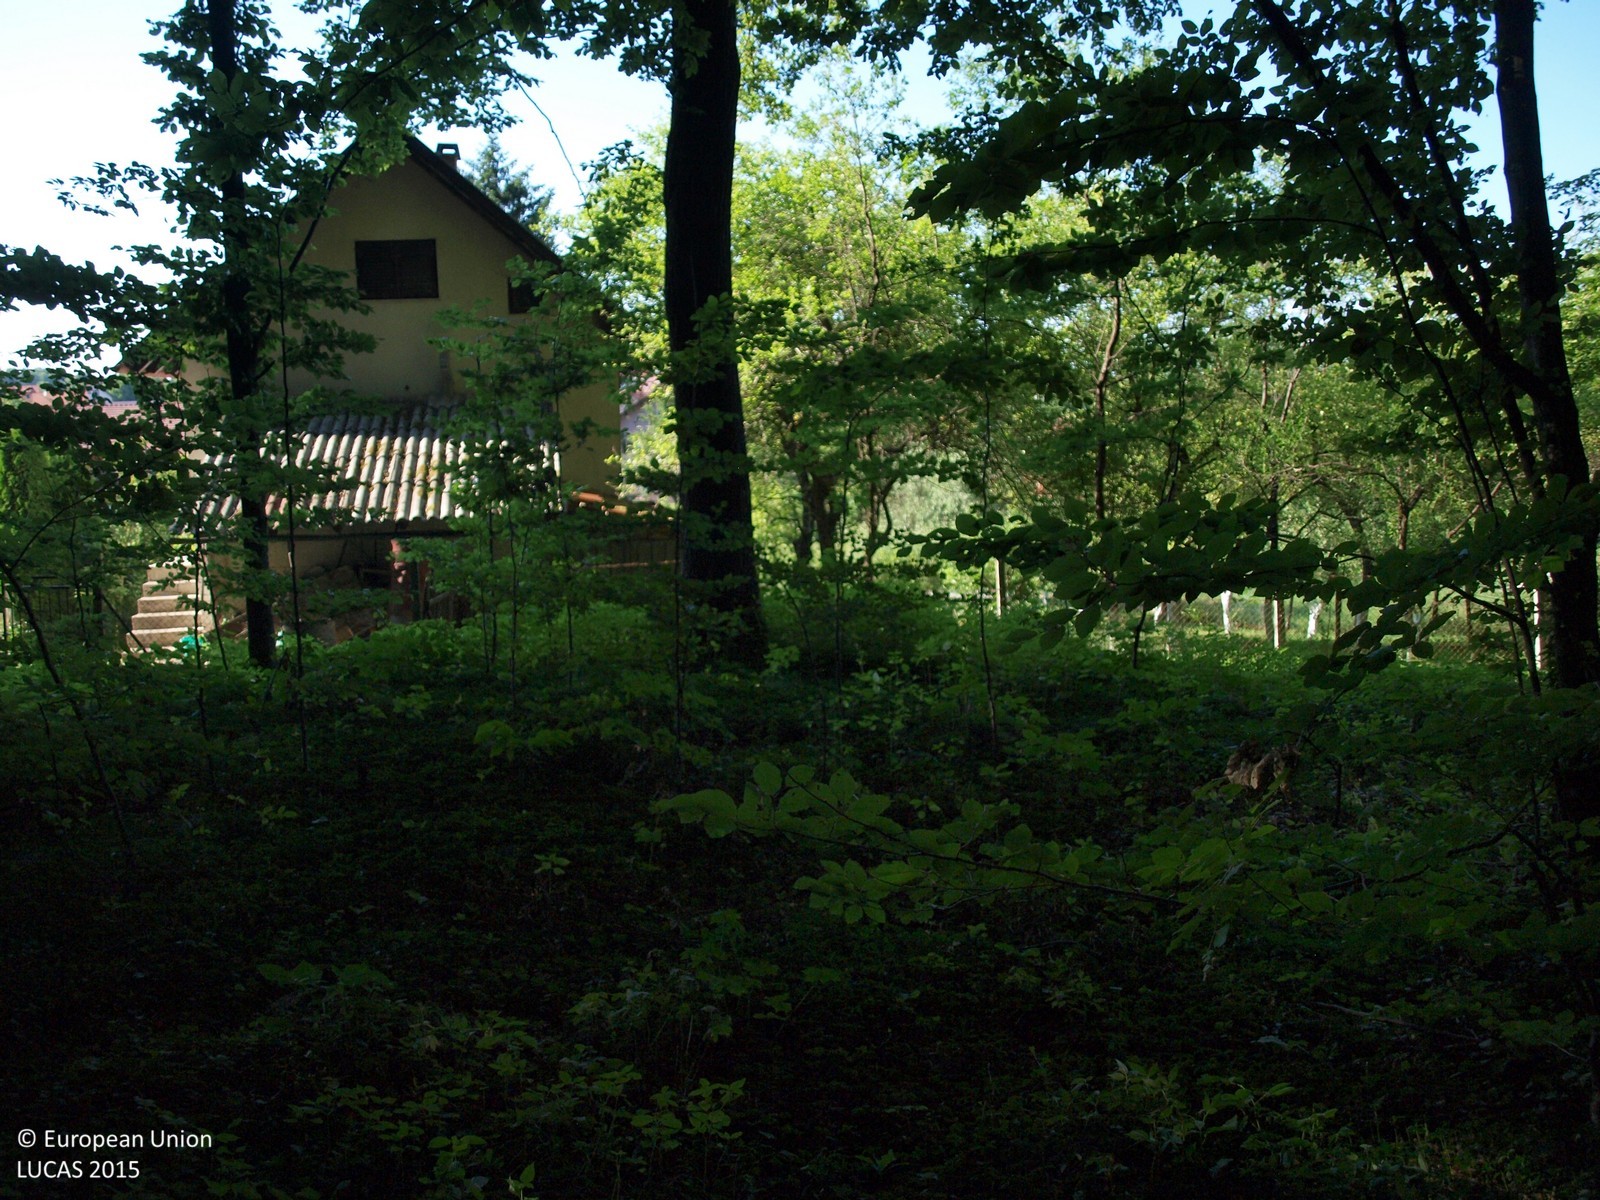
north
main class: Woodland
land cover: Broadleaved woodland
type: beech forest
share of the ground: > 75 %
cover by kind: broadleaved forest trees 100 %
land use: Forestry
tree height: > 5 m
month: July
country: HR
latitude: 45.9704
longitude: 15.9218
